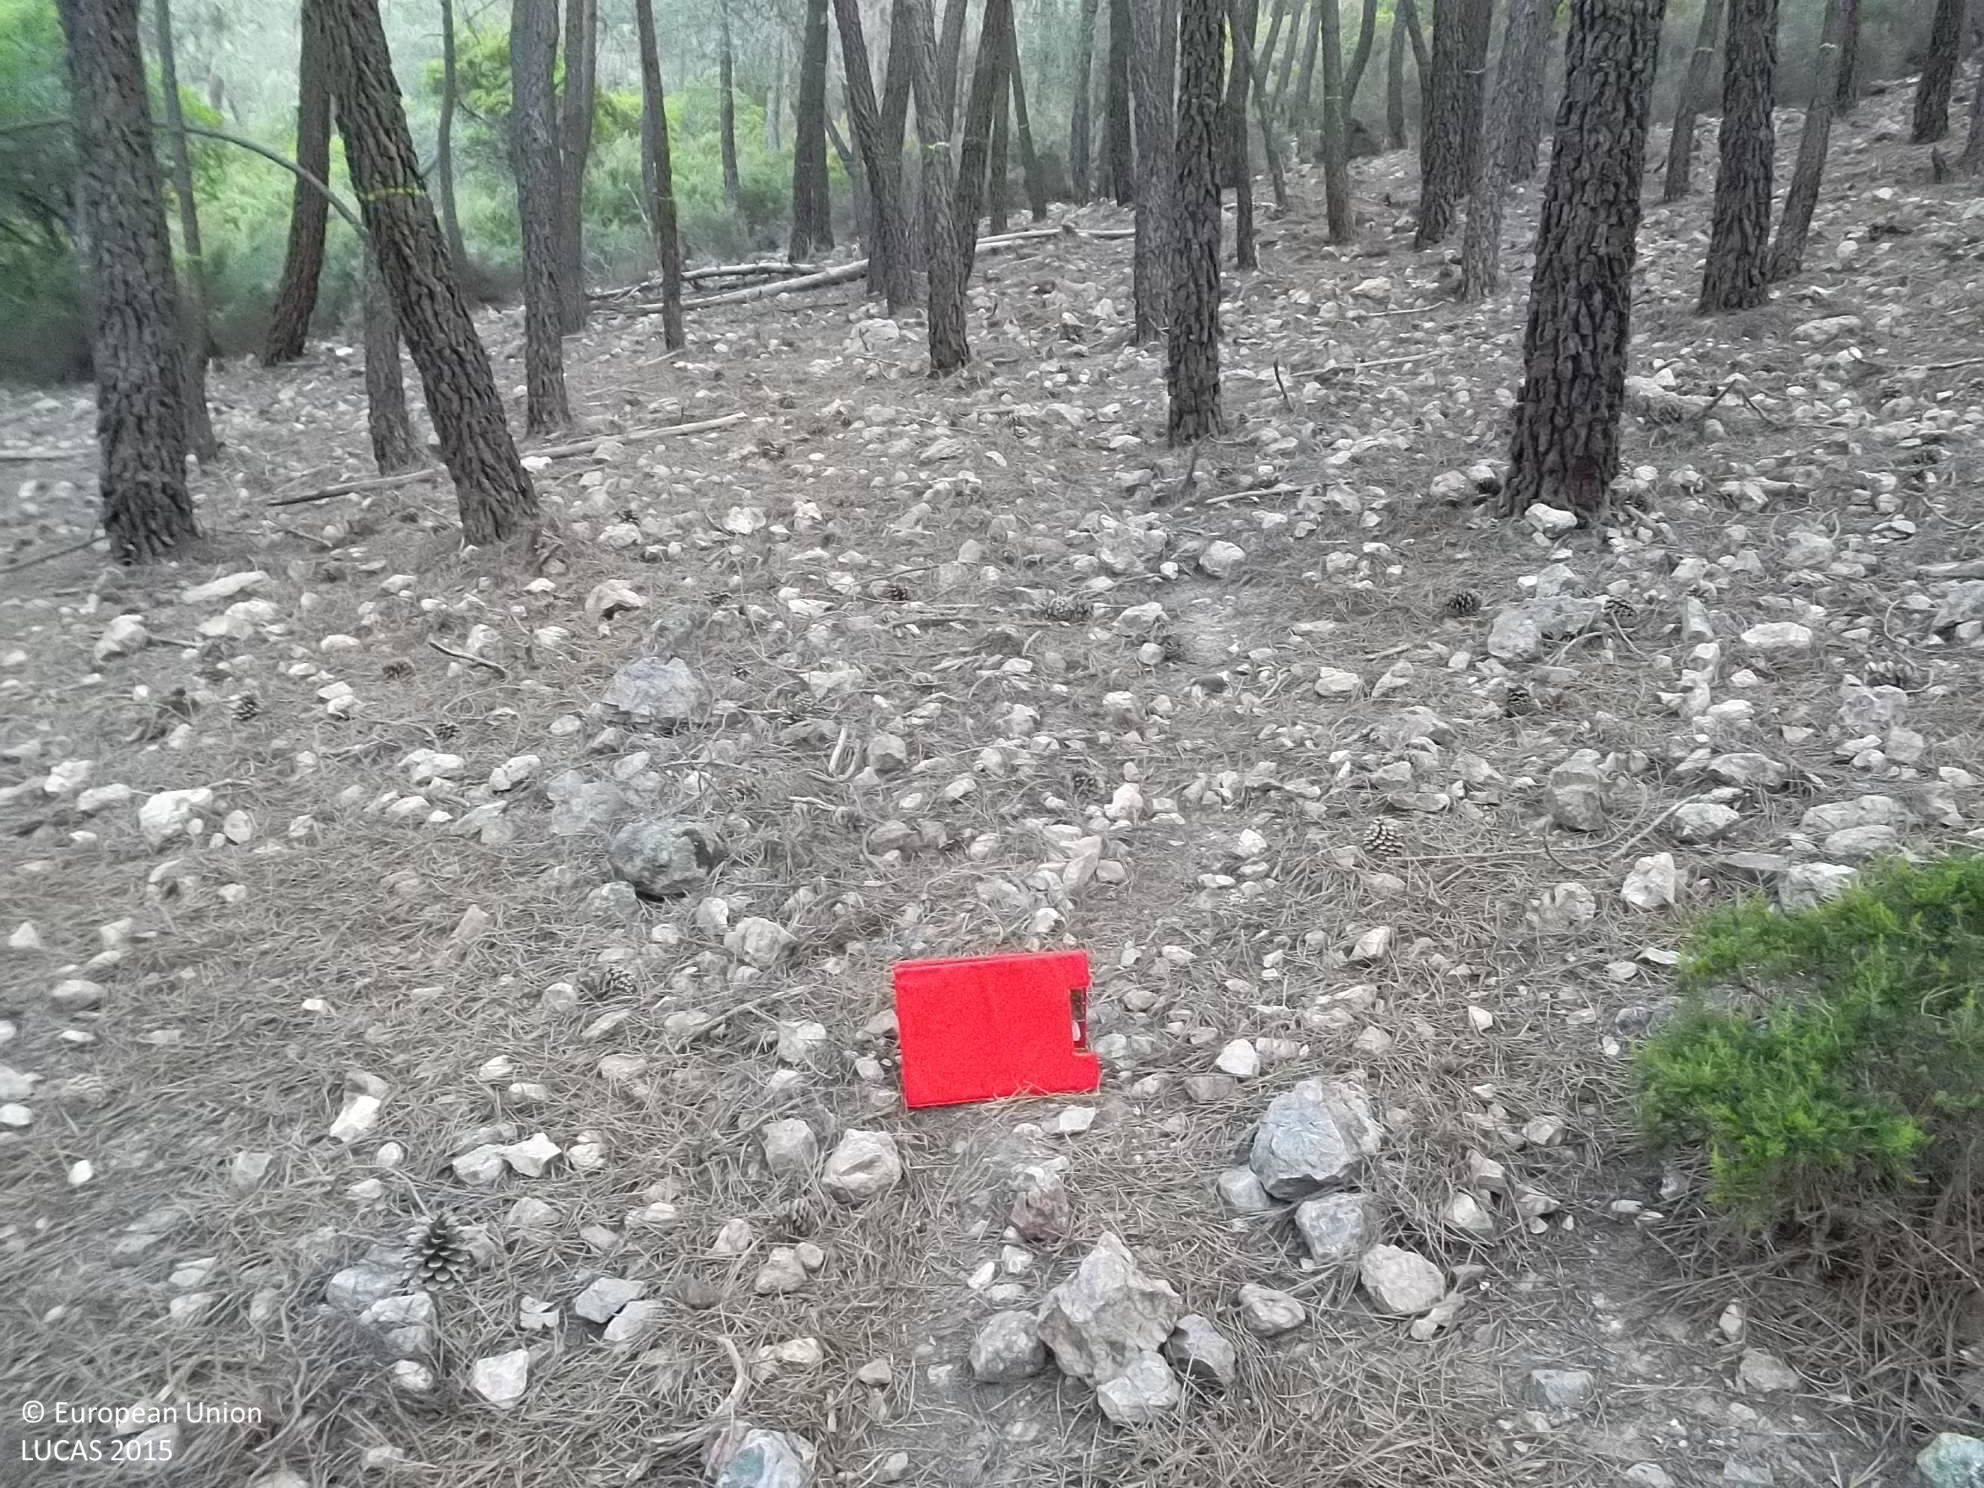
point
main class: Woodland
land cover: Pine dominated coniferous woodland
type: coniferous forest of the mediterranean region
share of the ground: 50 - 75 %
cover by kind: coniferous forest trees 90 %, shrubs 10 %
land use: Forestry
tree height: > 5 m
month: June
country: ES
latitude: 39.2147
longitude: -4.8969
